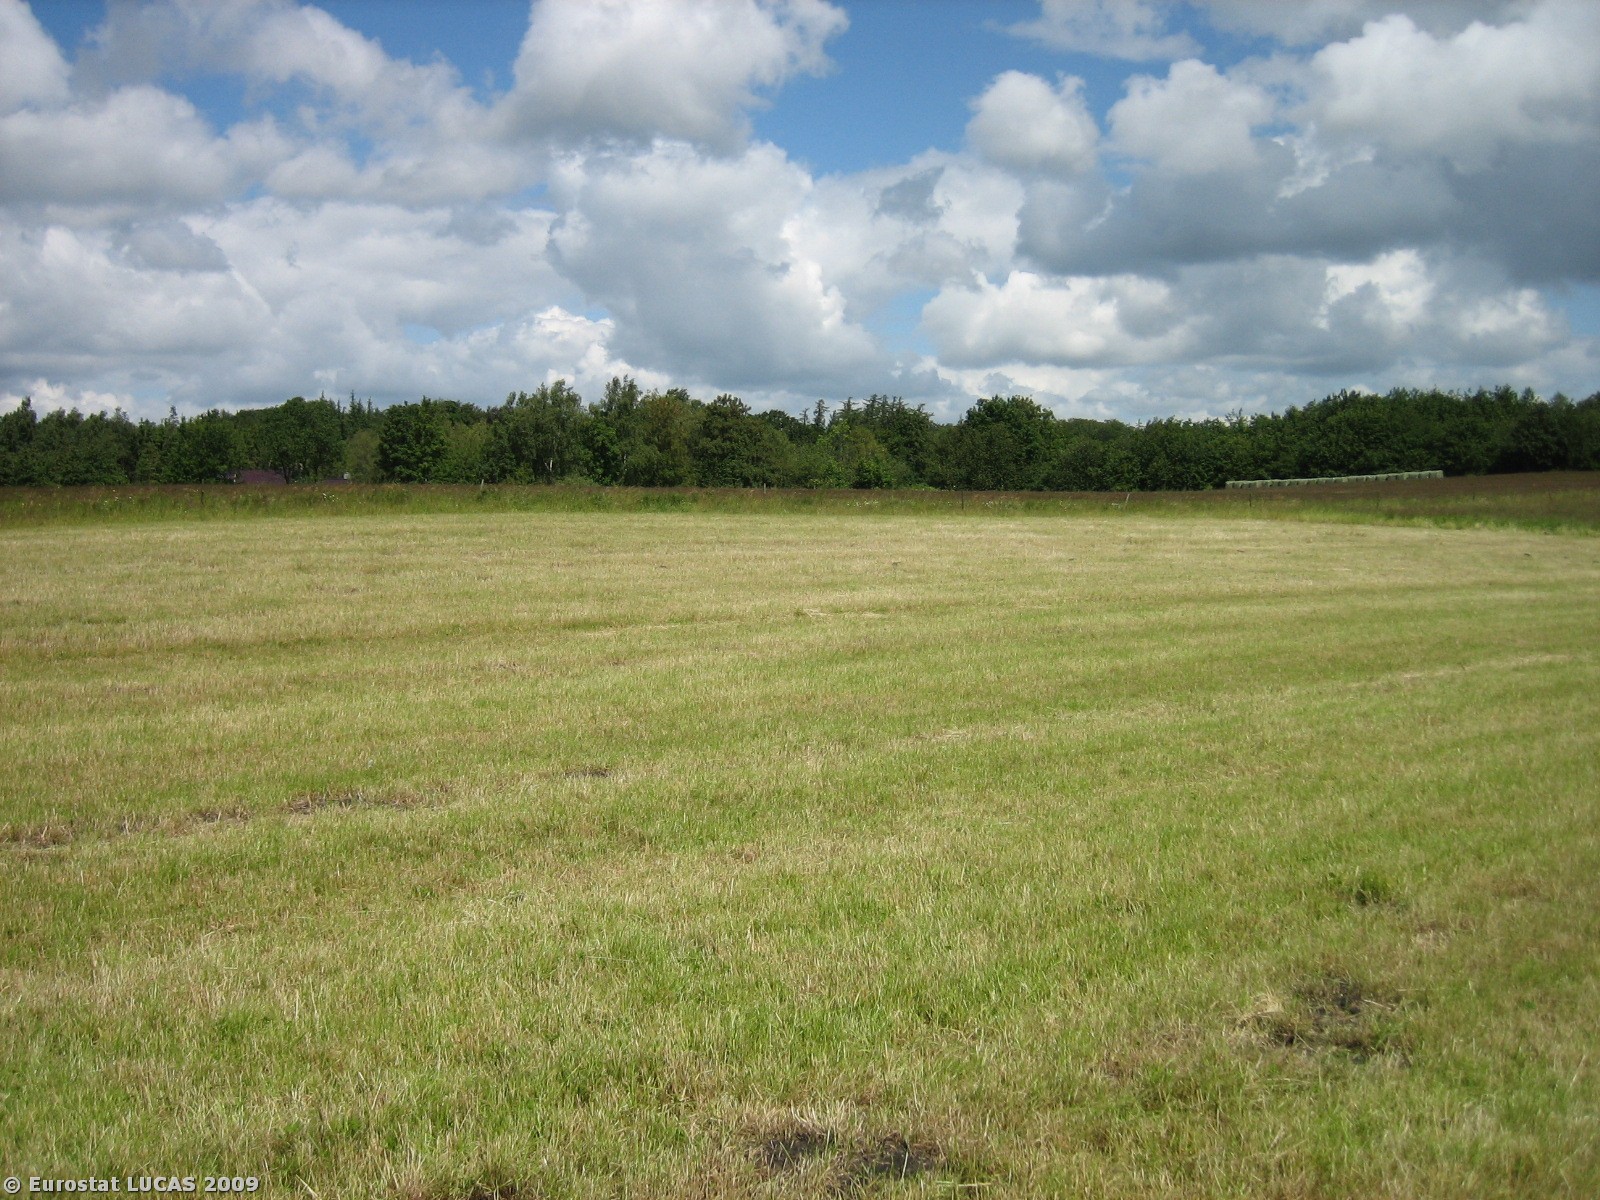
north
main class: Cropland
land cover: Temporary grasslands
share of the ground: > 75 %
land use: Agriculture (excluding fallow land and kitchen gardens)
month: June
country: DK
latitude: 55.5927
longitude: 9.3183
